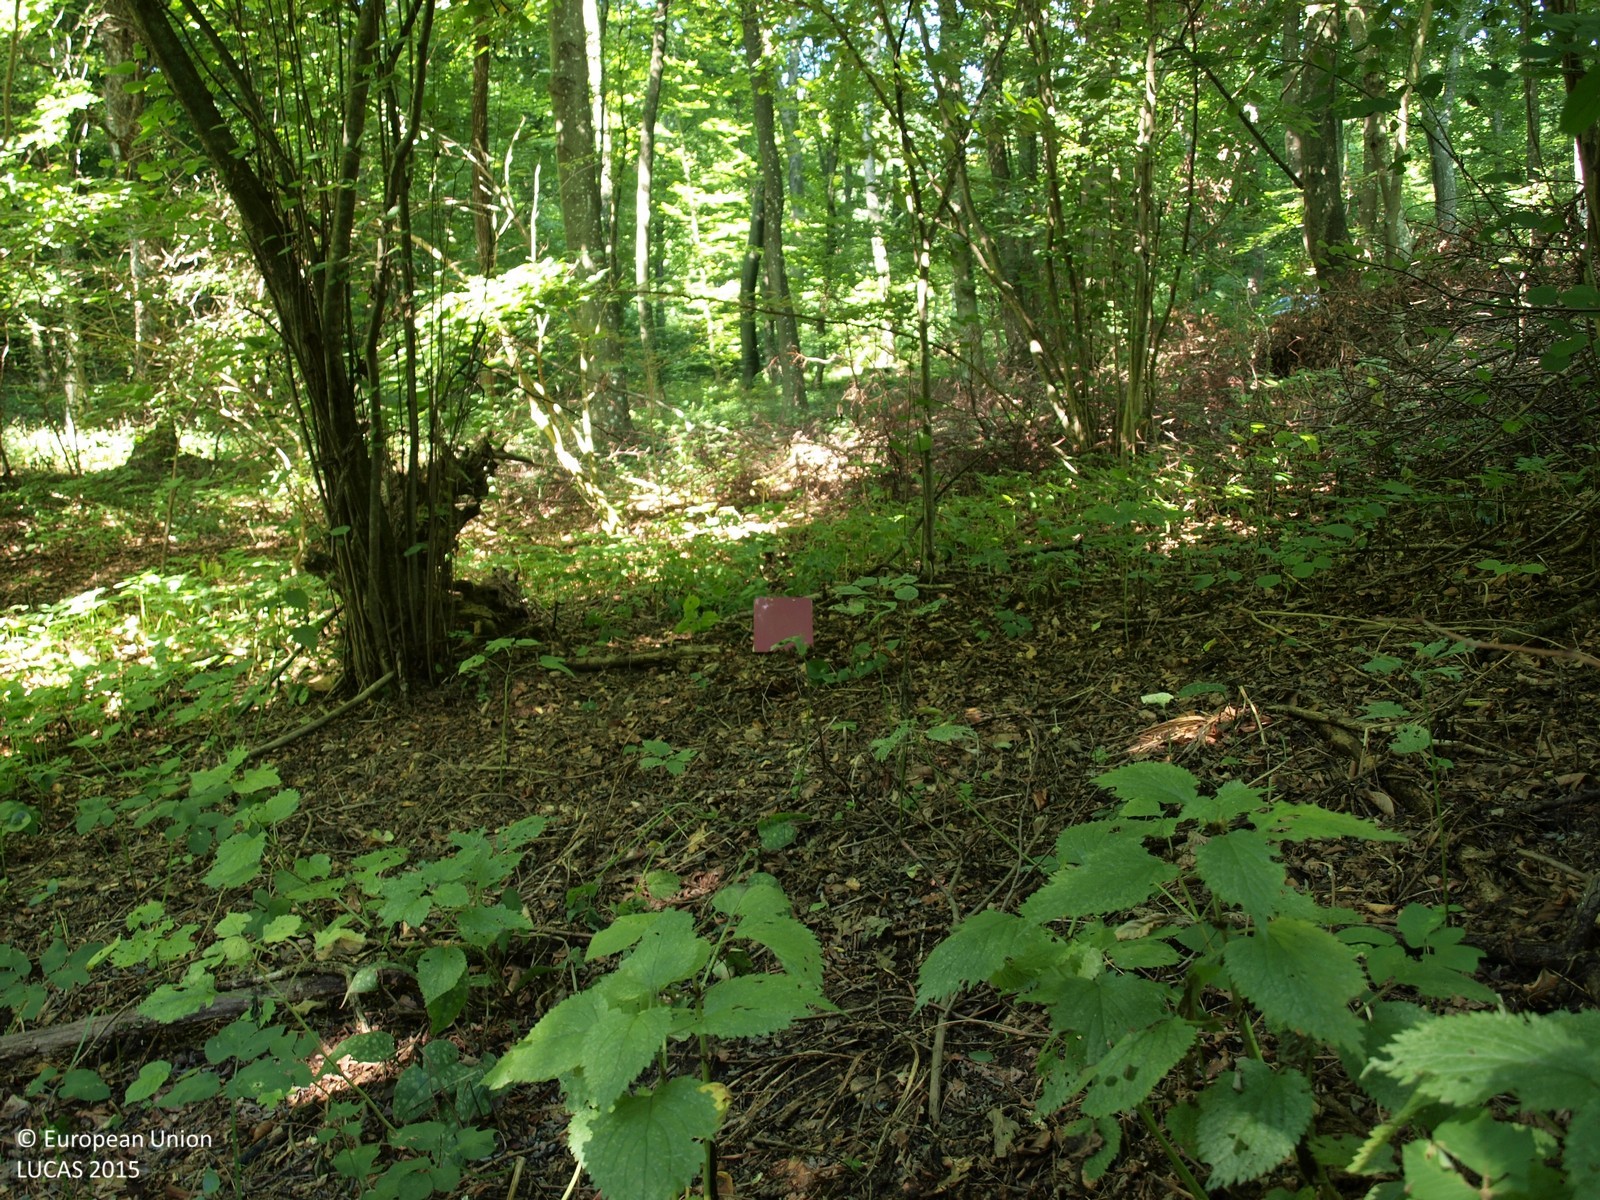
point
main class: Woodland
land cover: Broadleaved woodland
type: beech forest
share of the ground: > 75 %
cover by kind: broadleaved forest trees 100 %
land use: Forestry
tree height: > 5 m
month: August
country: HR
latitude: 46.1020
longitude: 16.4550
